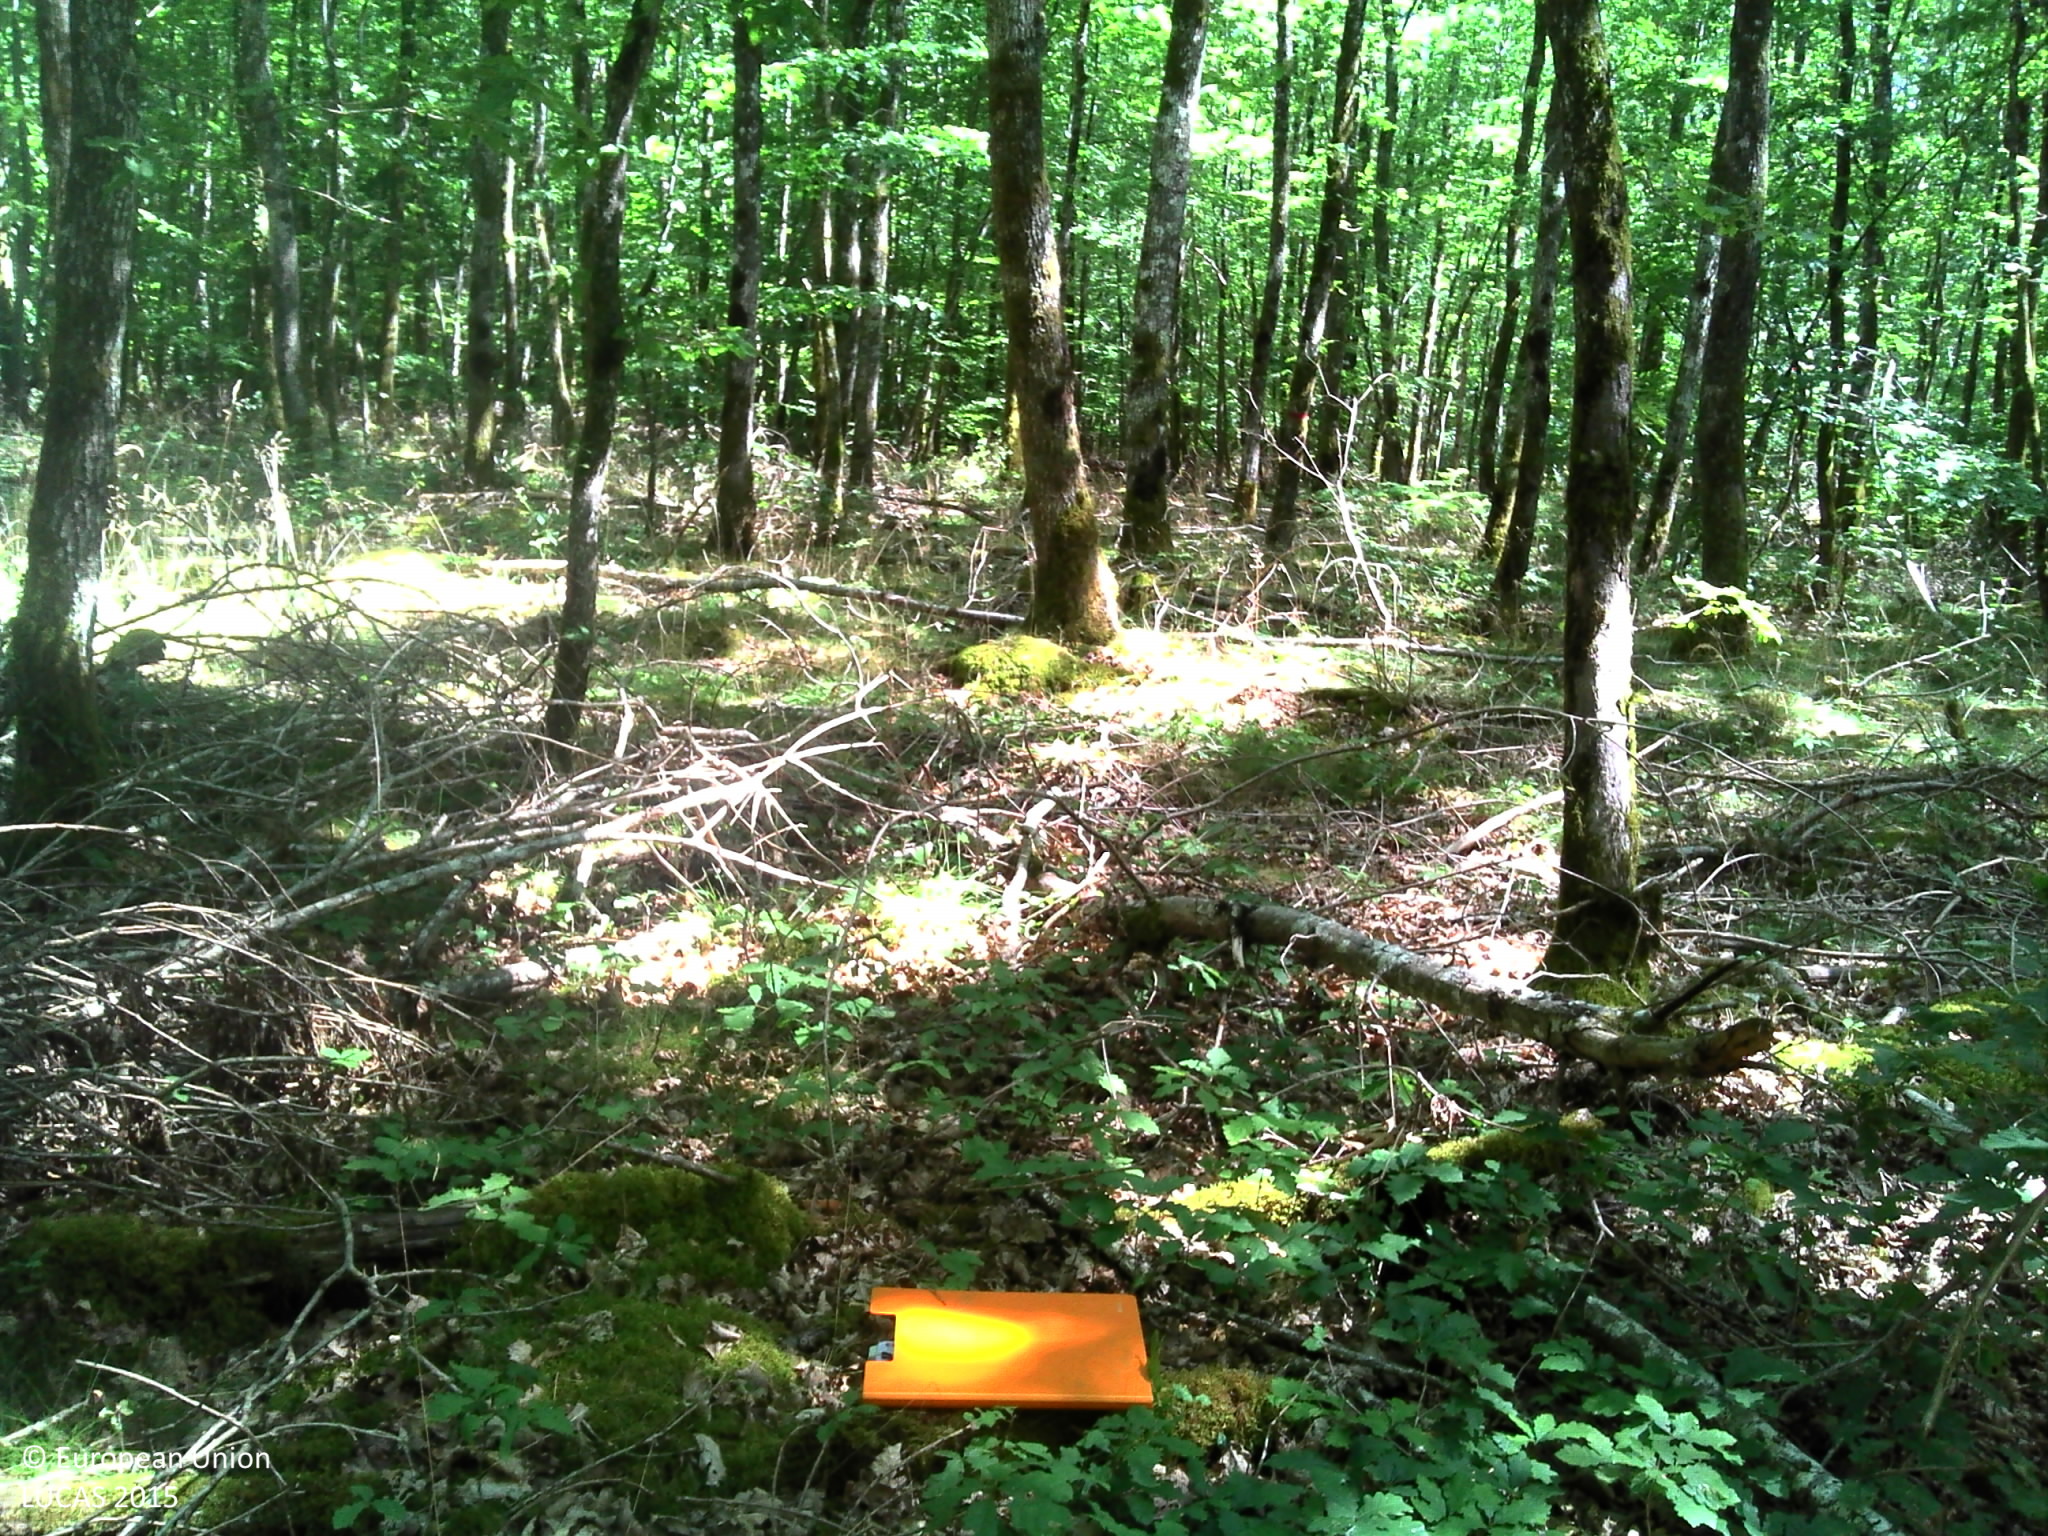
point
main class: Woodland
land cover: Broadleaved woodland
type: mesophytic deciduous forest
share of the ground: > 75 %
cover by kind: broadleaved forest trees 100 %
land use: Forestry
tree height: > 5 m
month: July
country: FR
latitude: 47.0948
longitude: 3.2378
